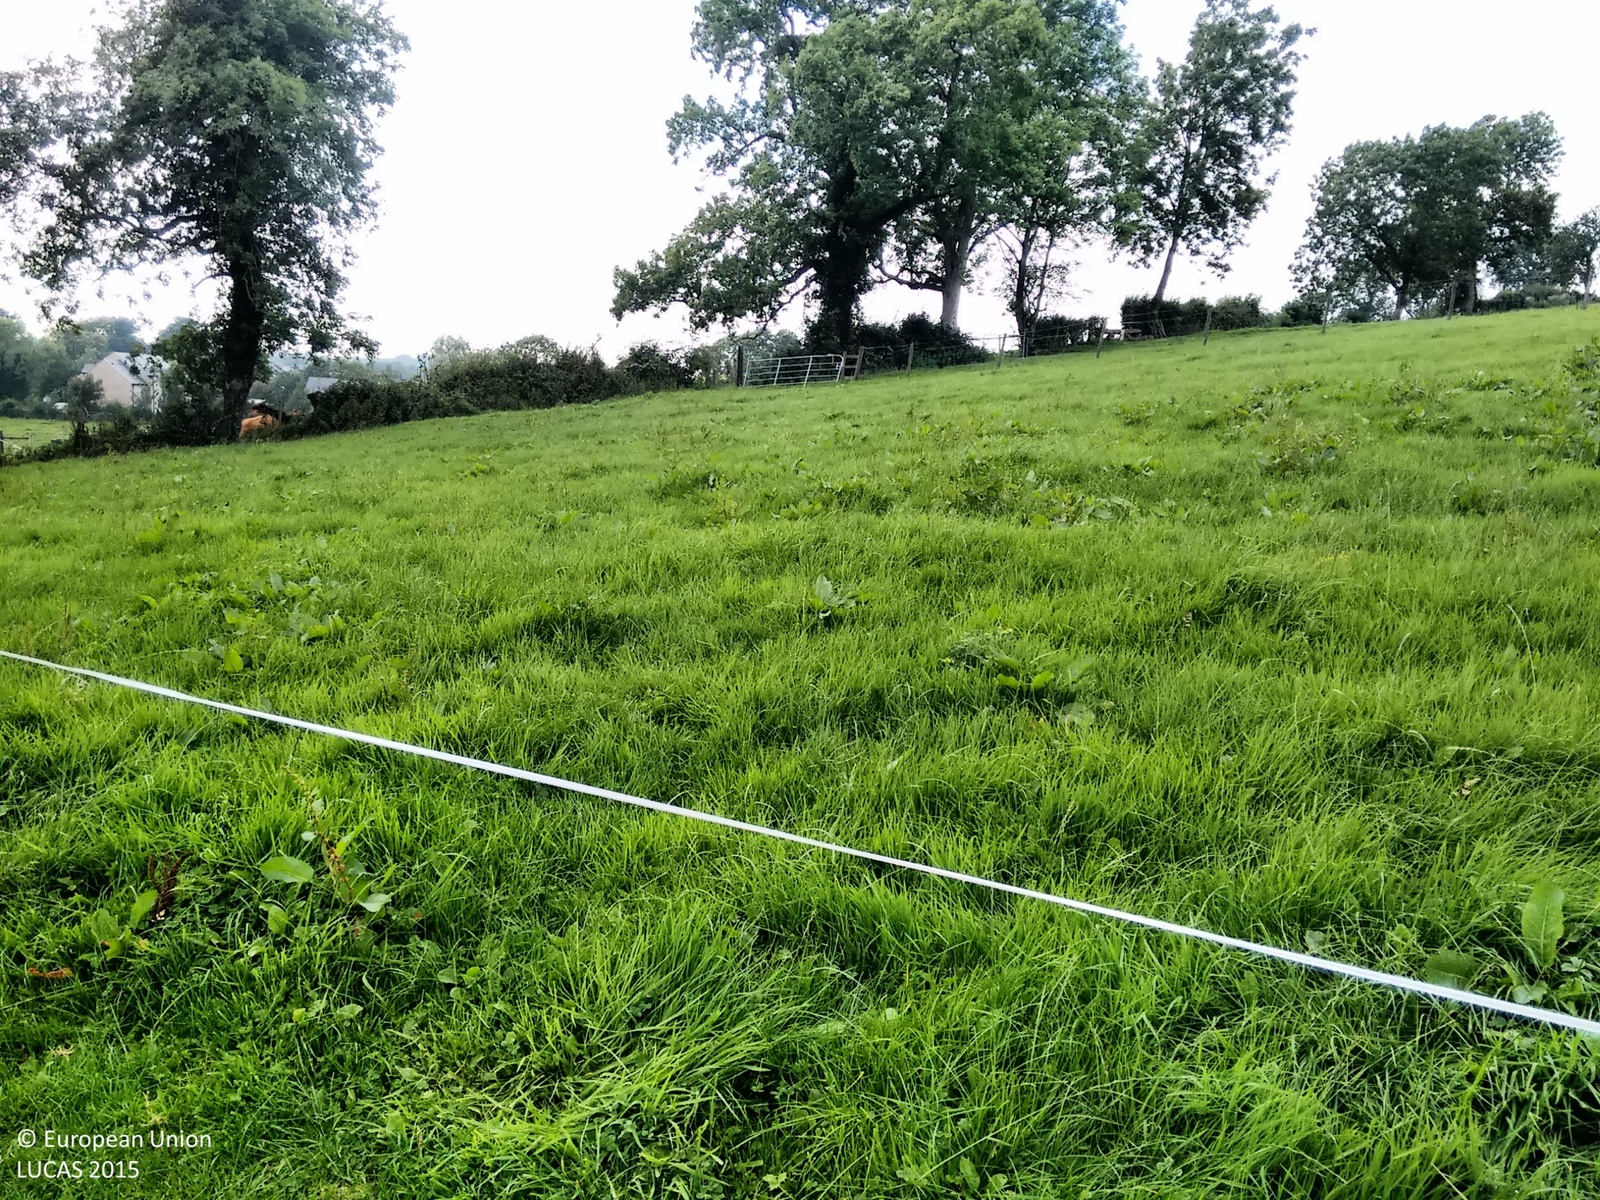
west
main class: Grassland
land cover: Grassland without tree/shrub cover
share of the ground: > 75 %
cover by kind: herbaceous plants 100 %
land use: Agriculture (excluding fallow land and kitchen gardens)
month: September
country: IE
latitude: 54.3163
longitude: -6.9086
